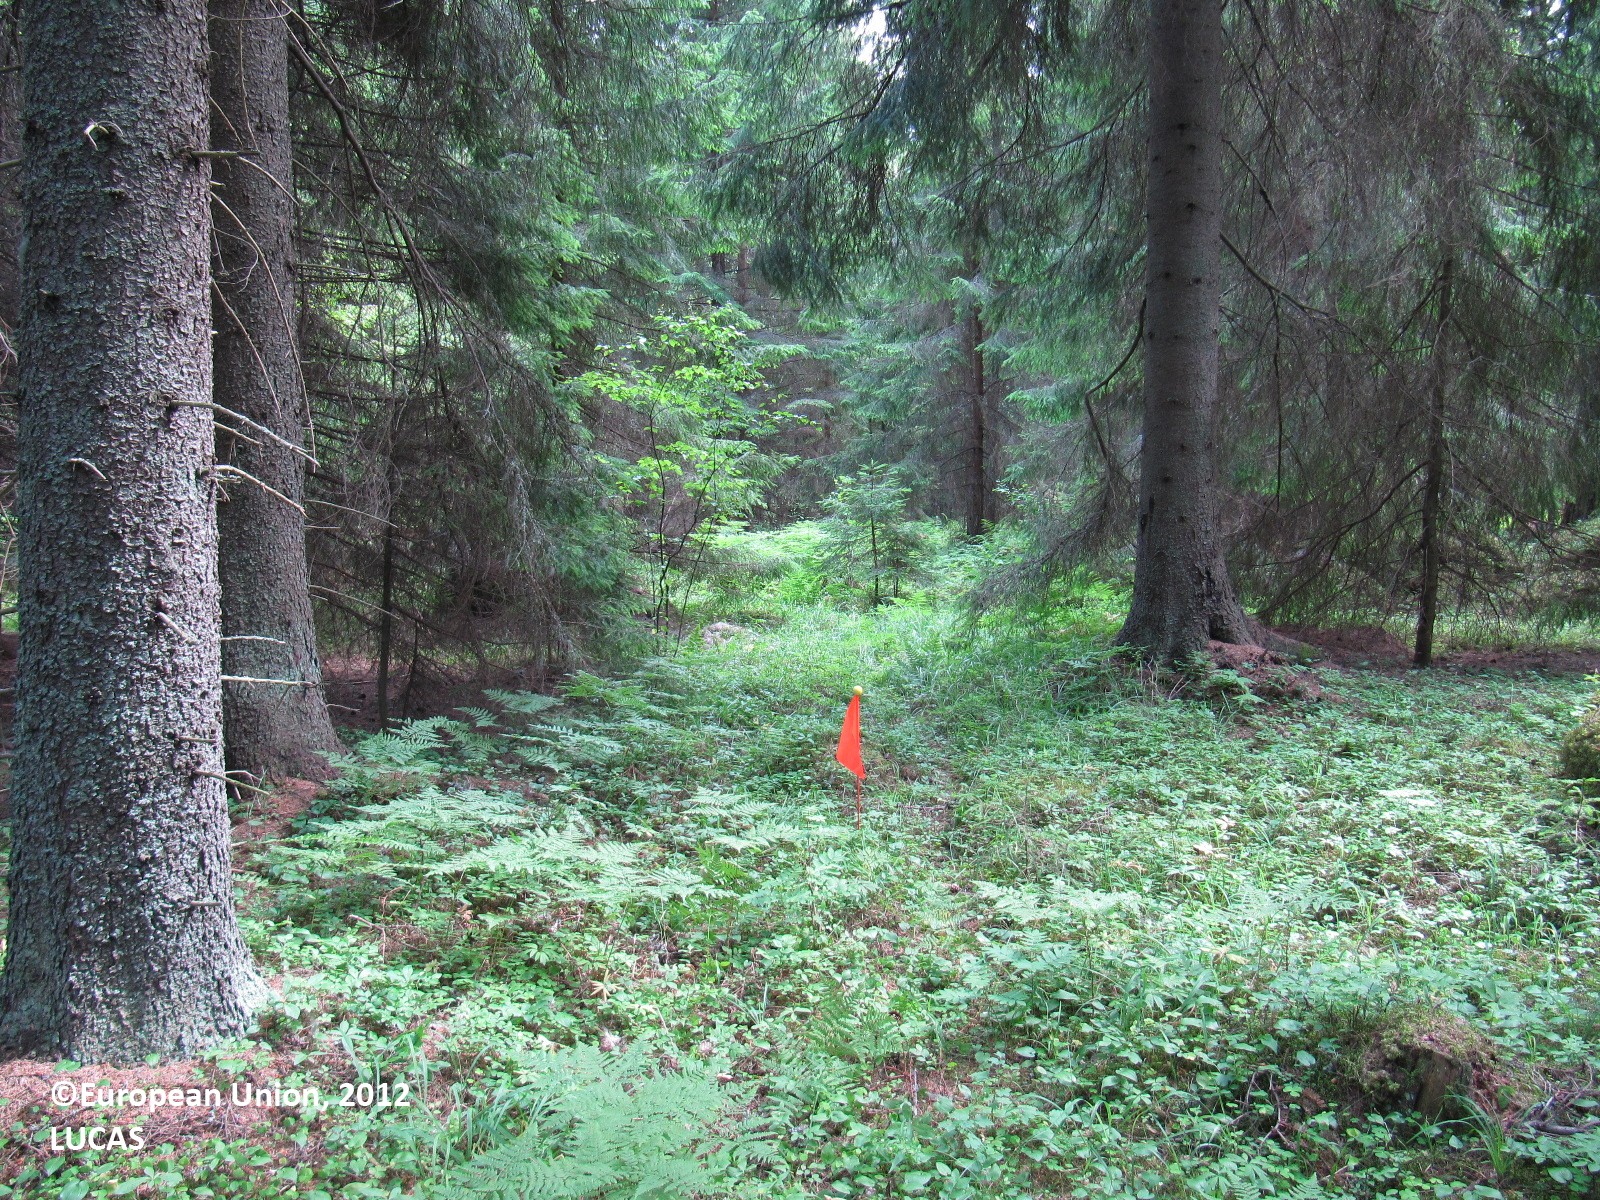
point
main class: Woodland
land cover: Spruce dominated coniferous woodland
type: boreal forest
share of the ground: > 75 %
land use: Forestry
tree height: > 5 m
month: July
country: FI
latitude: 61.0149
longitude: 23.4574
